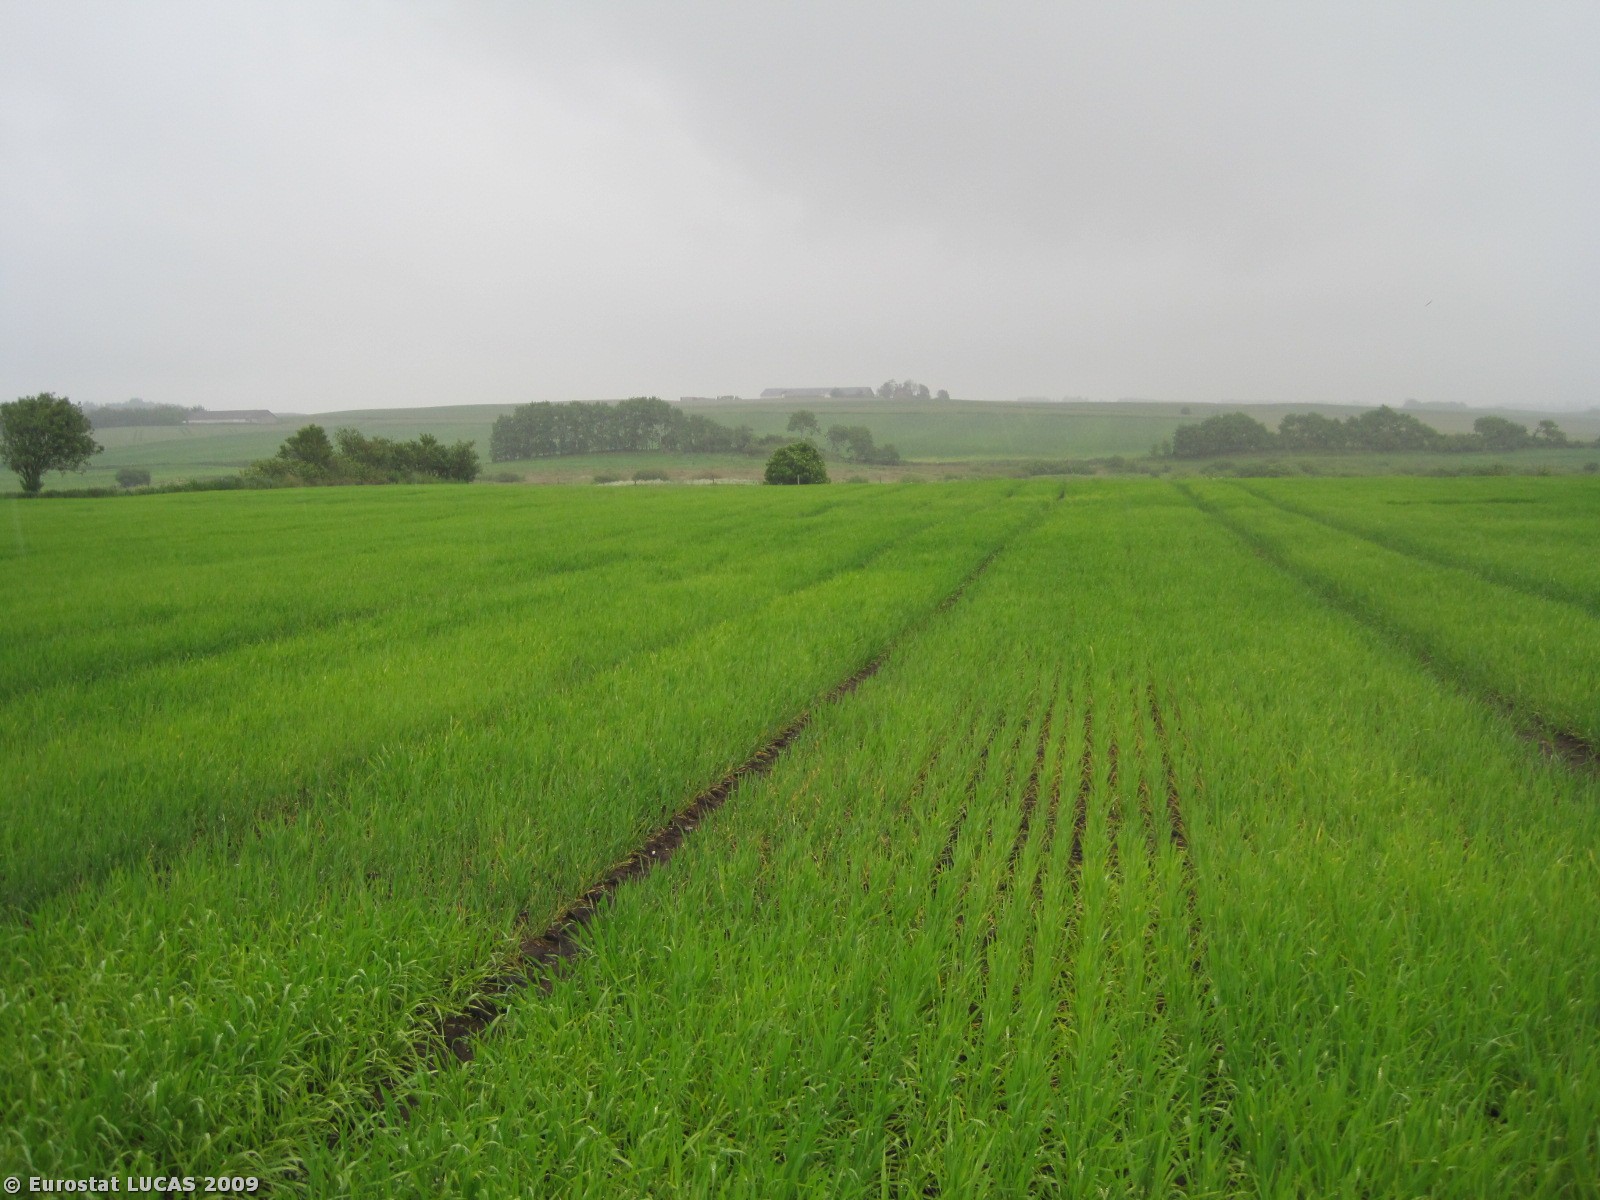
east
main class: Cropland
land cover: Barley
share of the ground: > 75 %
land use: Agriculture (excluding fallow land and kitchen gardens)
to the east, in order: Barley; Fences; Grassland with sparse tree/shrub cover; Ditches and canals; Grassland without tree/shrub cover
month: June
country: DK
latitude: 57.3563
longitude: 10.0830
